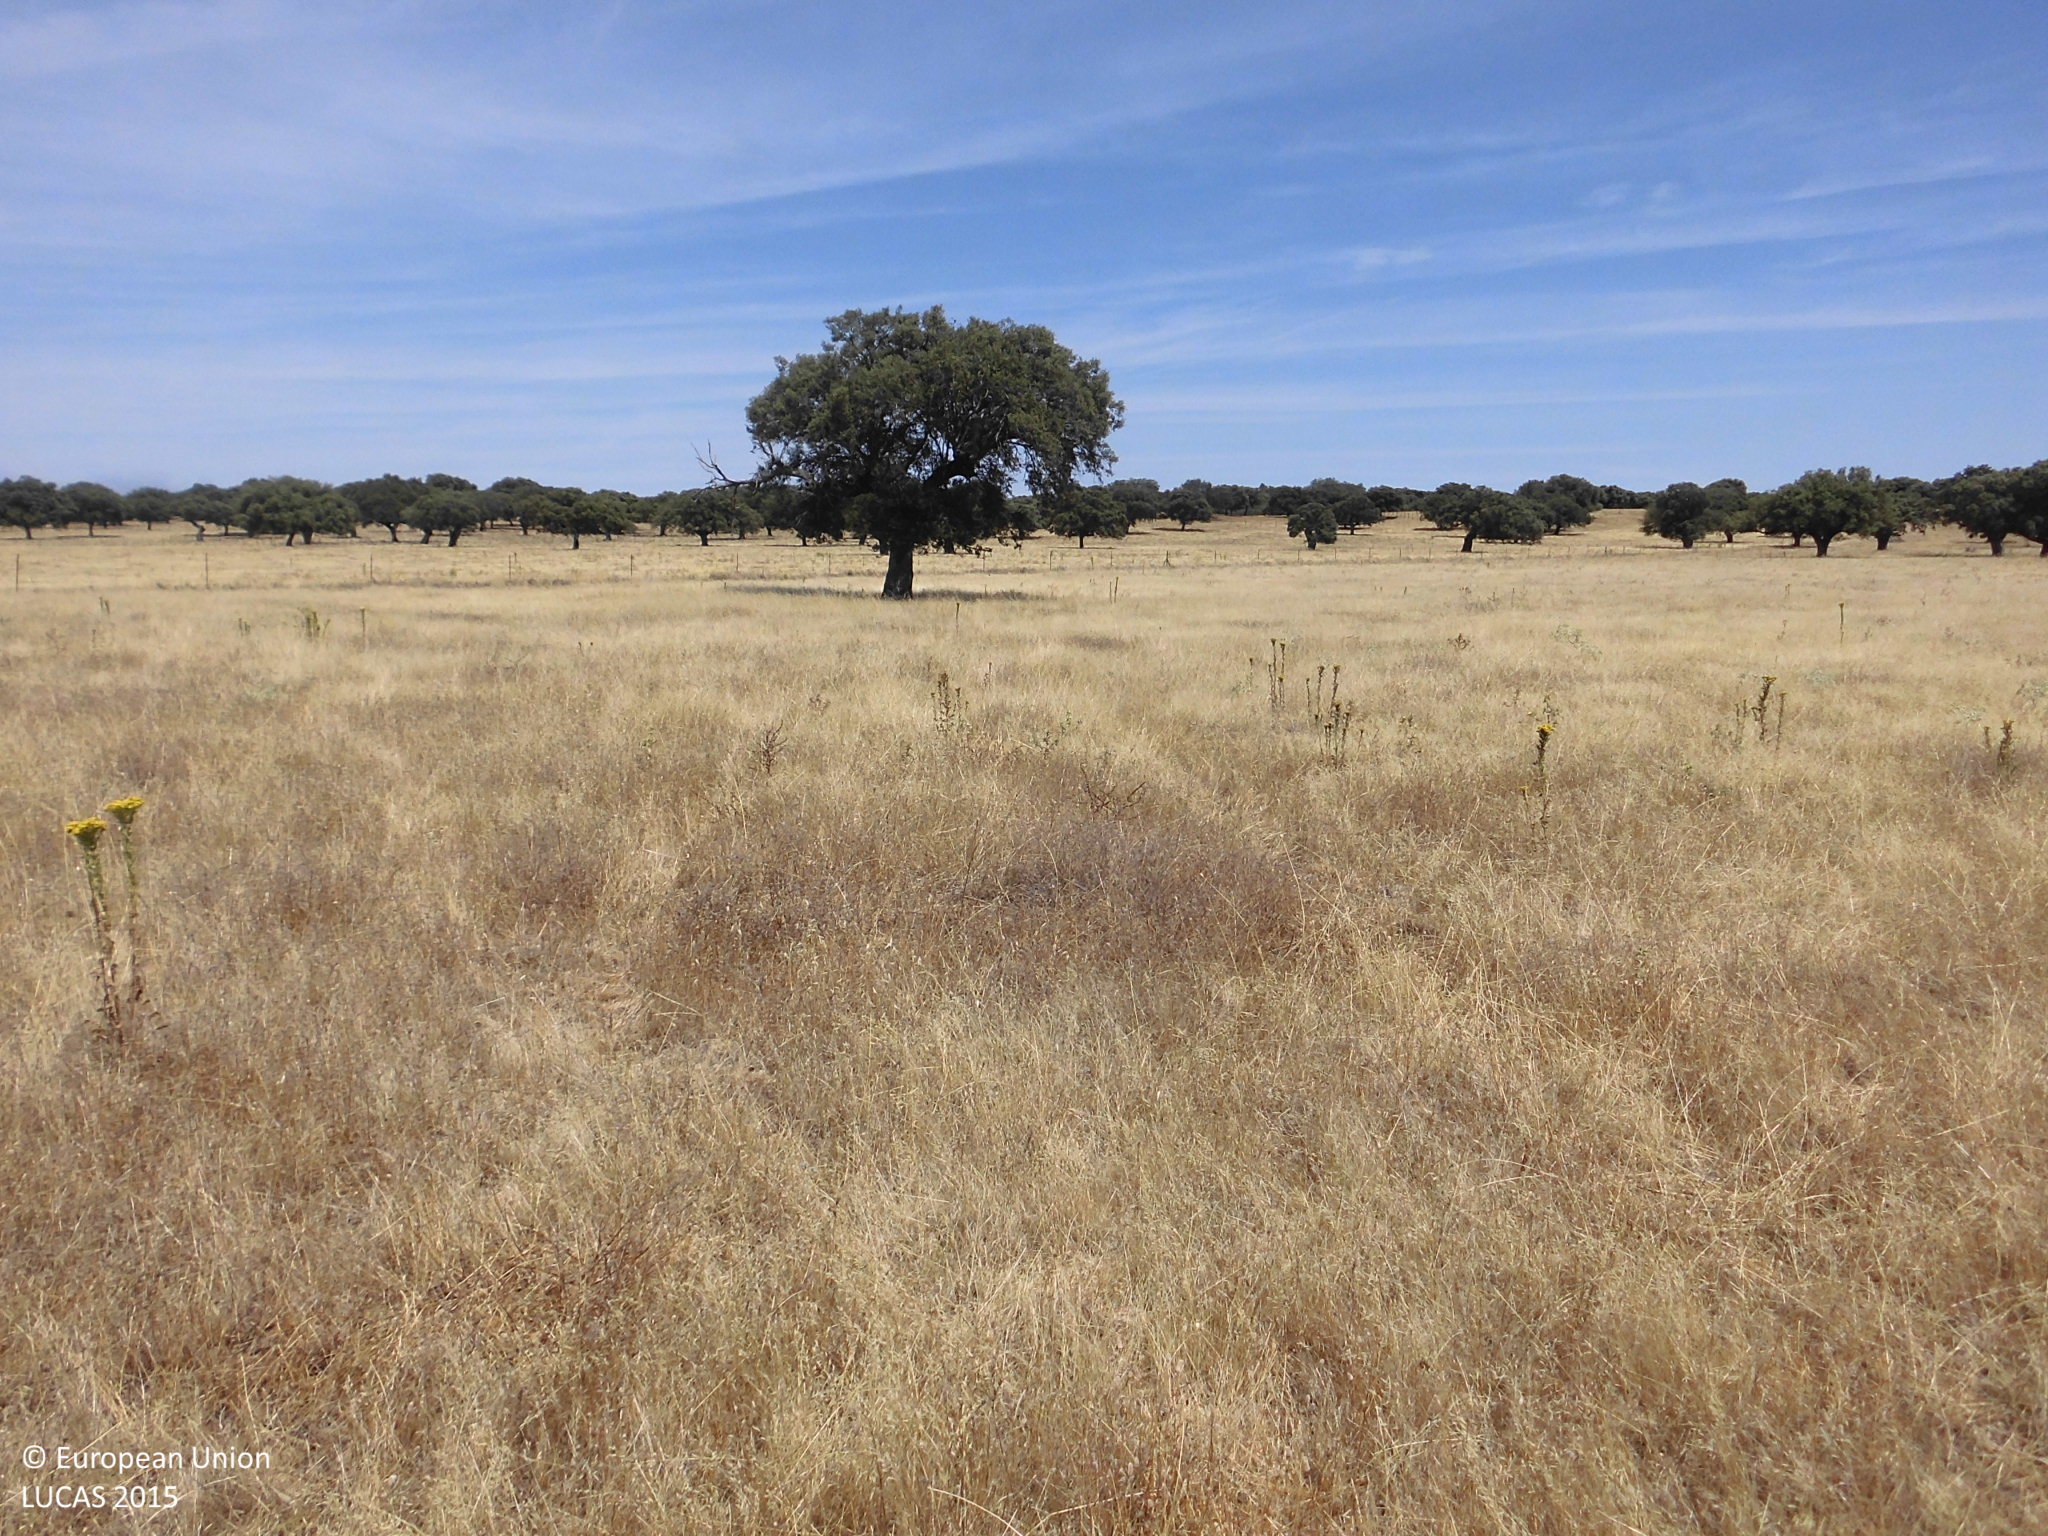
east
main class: Woodland
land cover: Broadleaved woodland
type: broadleaved evergreen forest
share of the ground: 10 - 25 %
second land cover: Grassland without tree/shrub cover
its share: > 75 %
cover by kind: herbaceous plants 90 %, broadleaved forest trees 10 %
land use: Forestry
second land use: Agriculture (excluding fallow land and kitchen gardens)
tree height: > 5 m
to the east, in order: Broadleaved woodland; Grassland without tree/shrub cover; Single bushes/trees; Grassland without tree/shrub cover; Fences; Grassland without tree/shrub cover; Grassland with sparse tree/shrub cover; Broadleaved woodland
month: July
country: ES
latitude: 39.8817
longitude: -6.5542
